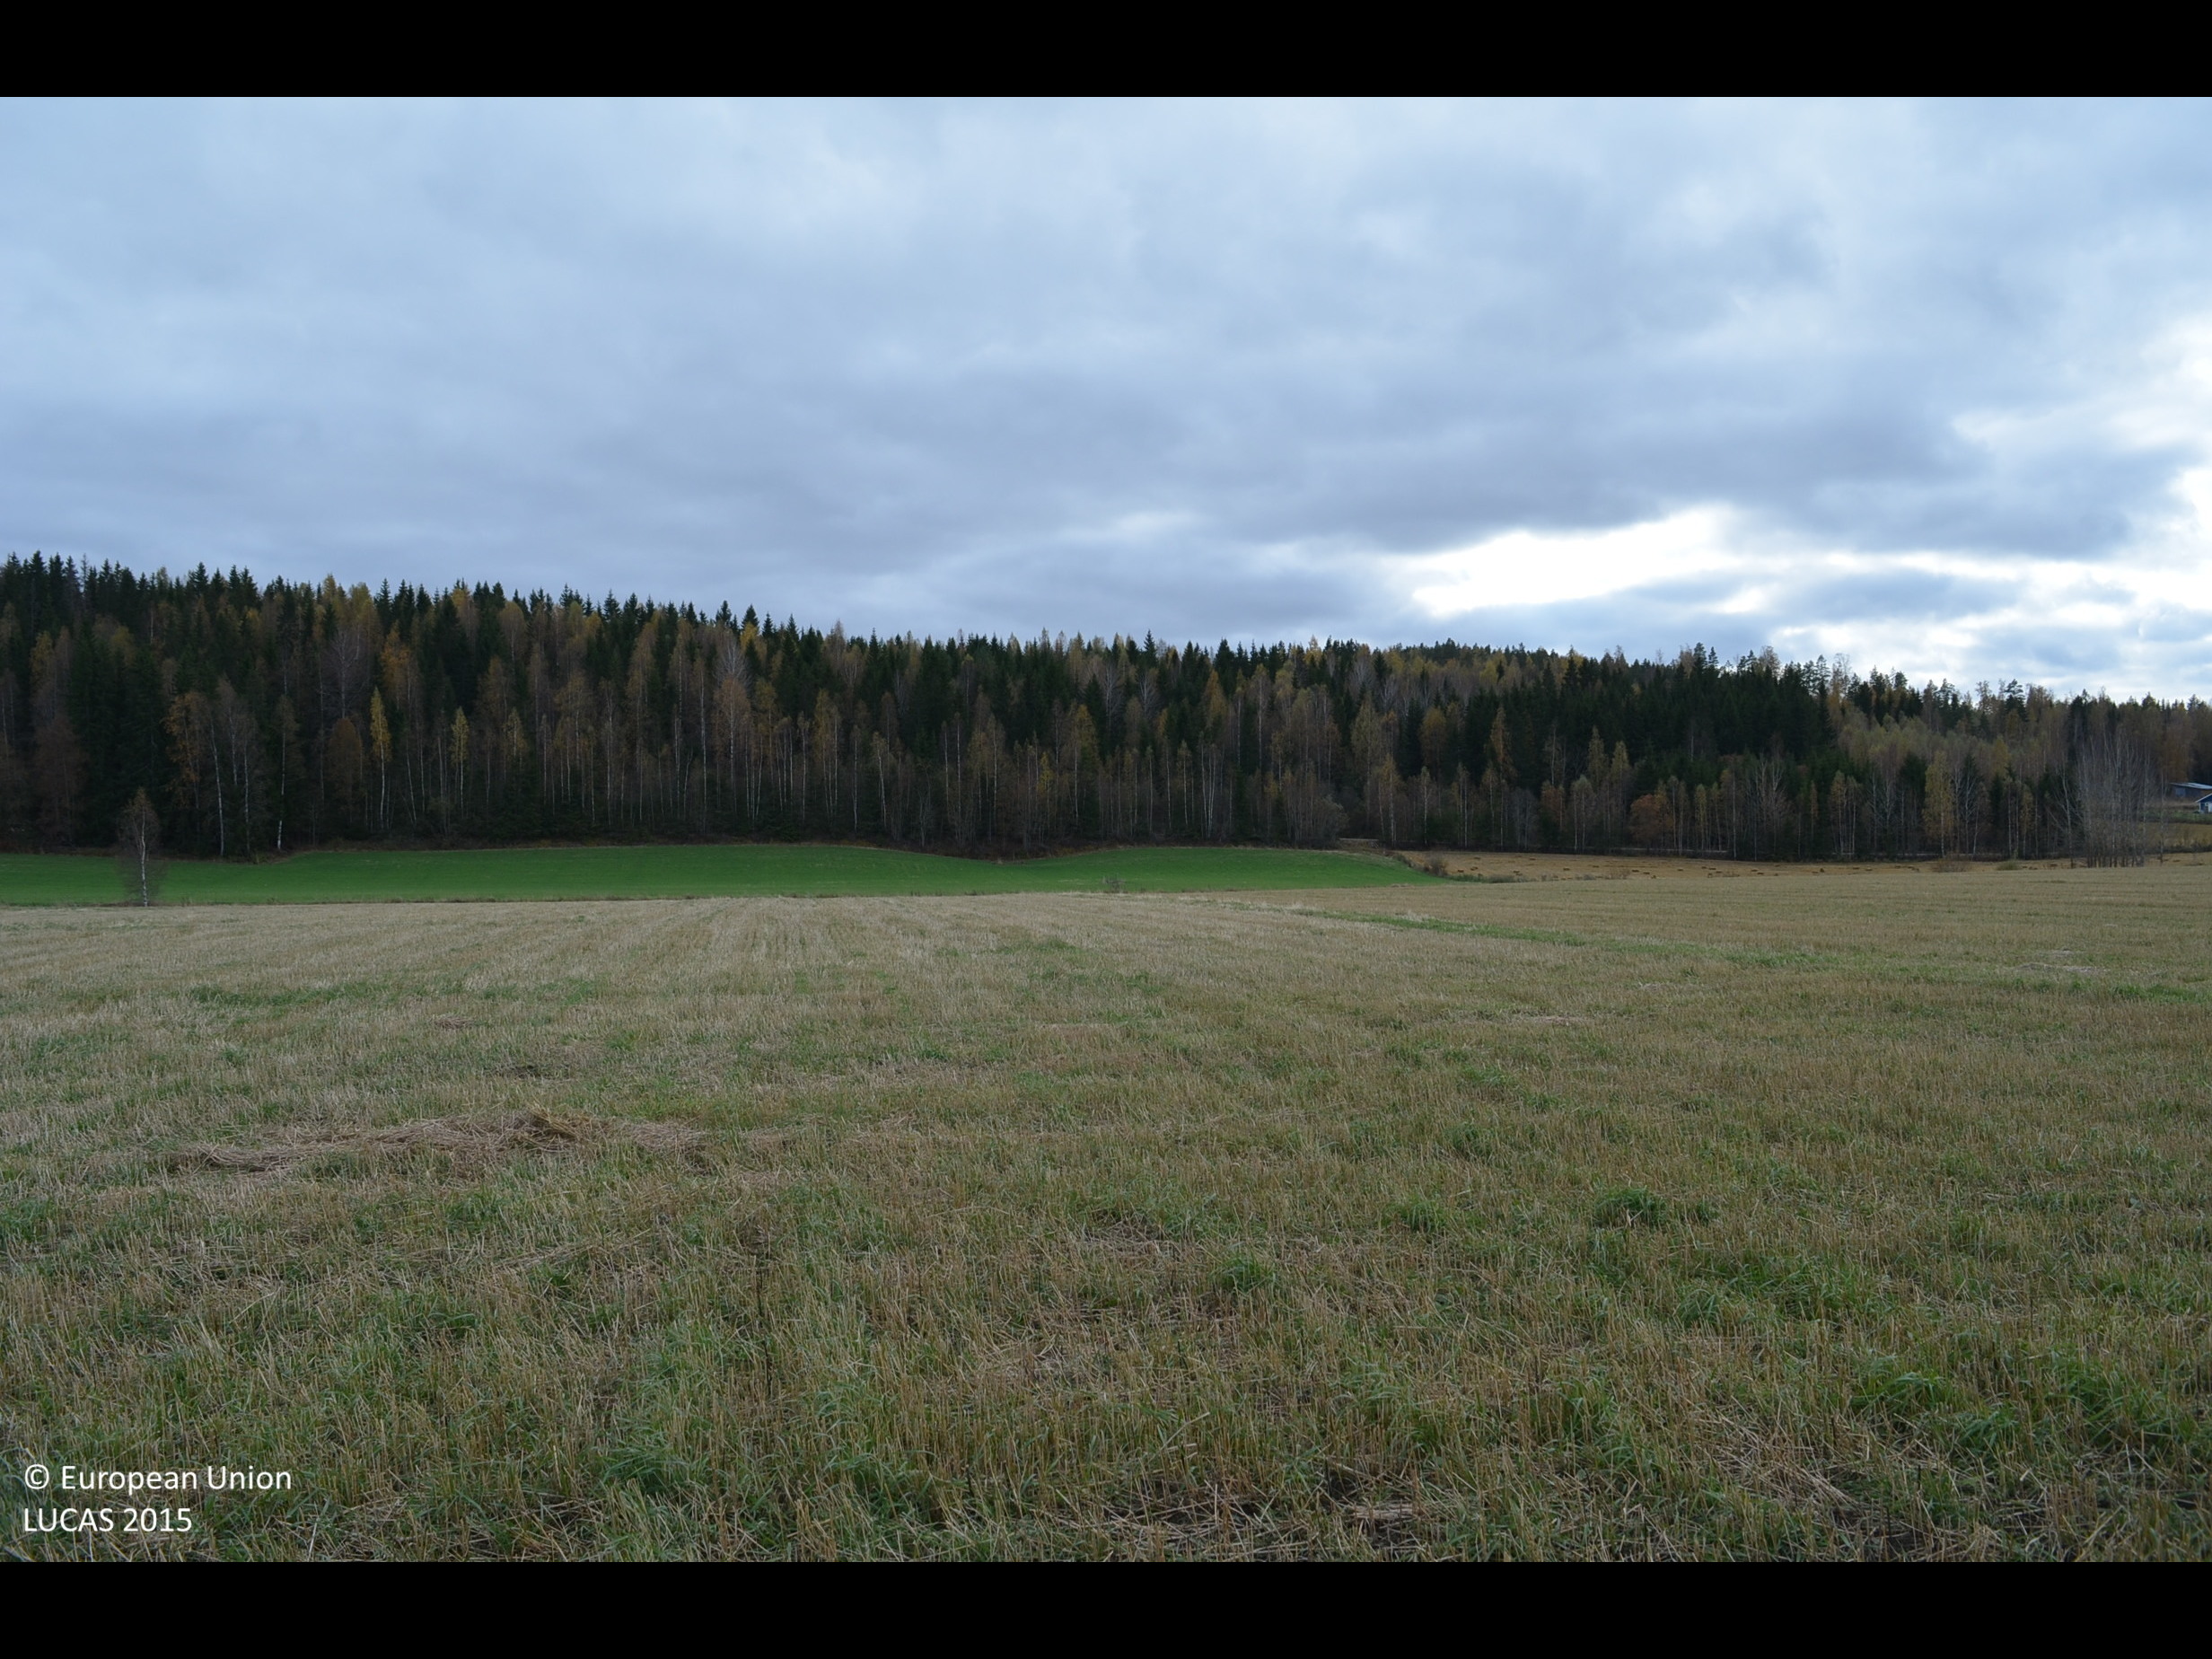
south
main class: Cropland
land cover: Barley
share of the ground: > 75 %
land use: Agriculture (excluding fallow land and kitchen gardens)
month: October
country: FI
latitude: 61.4996
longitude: 23.1679
